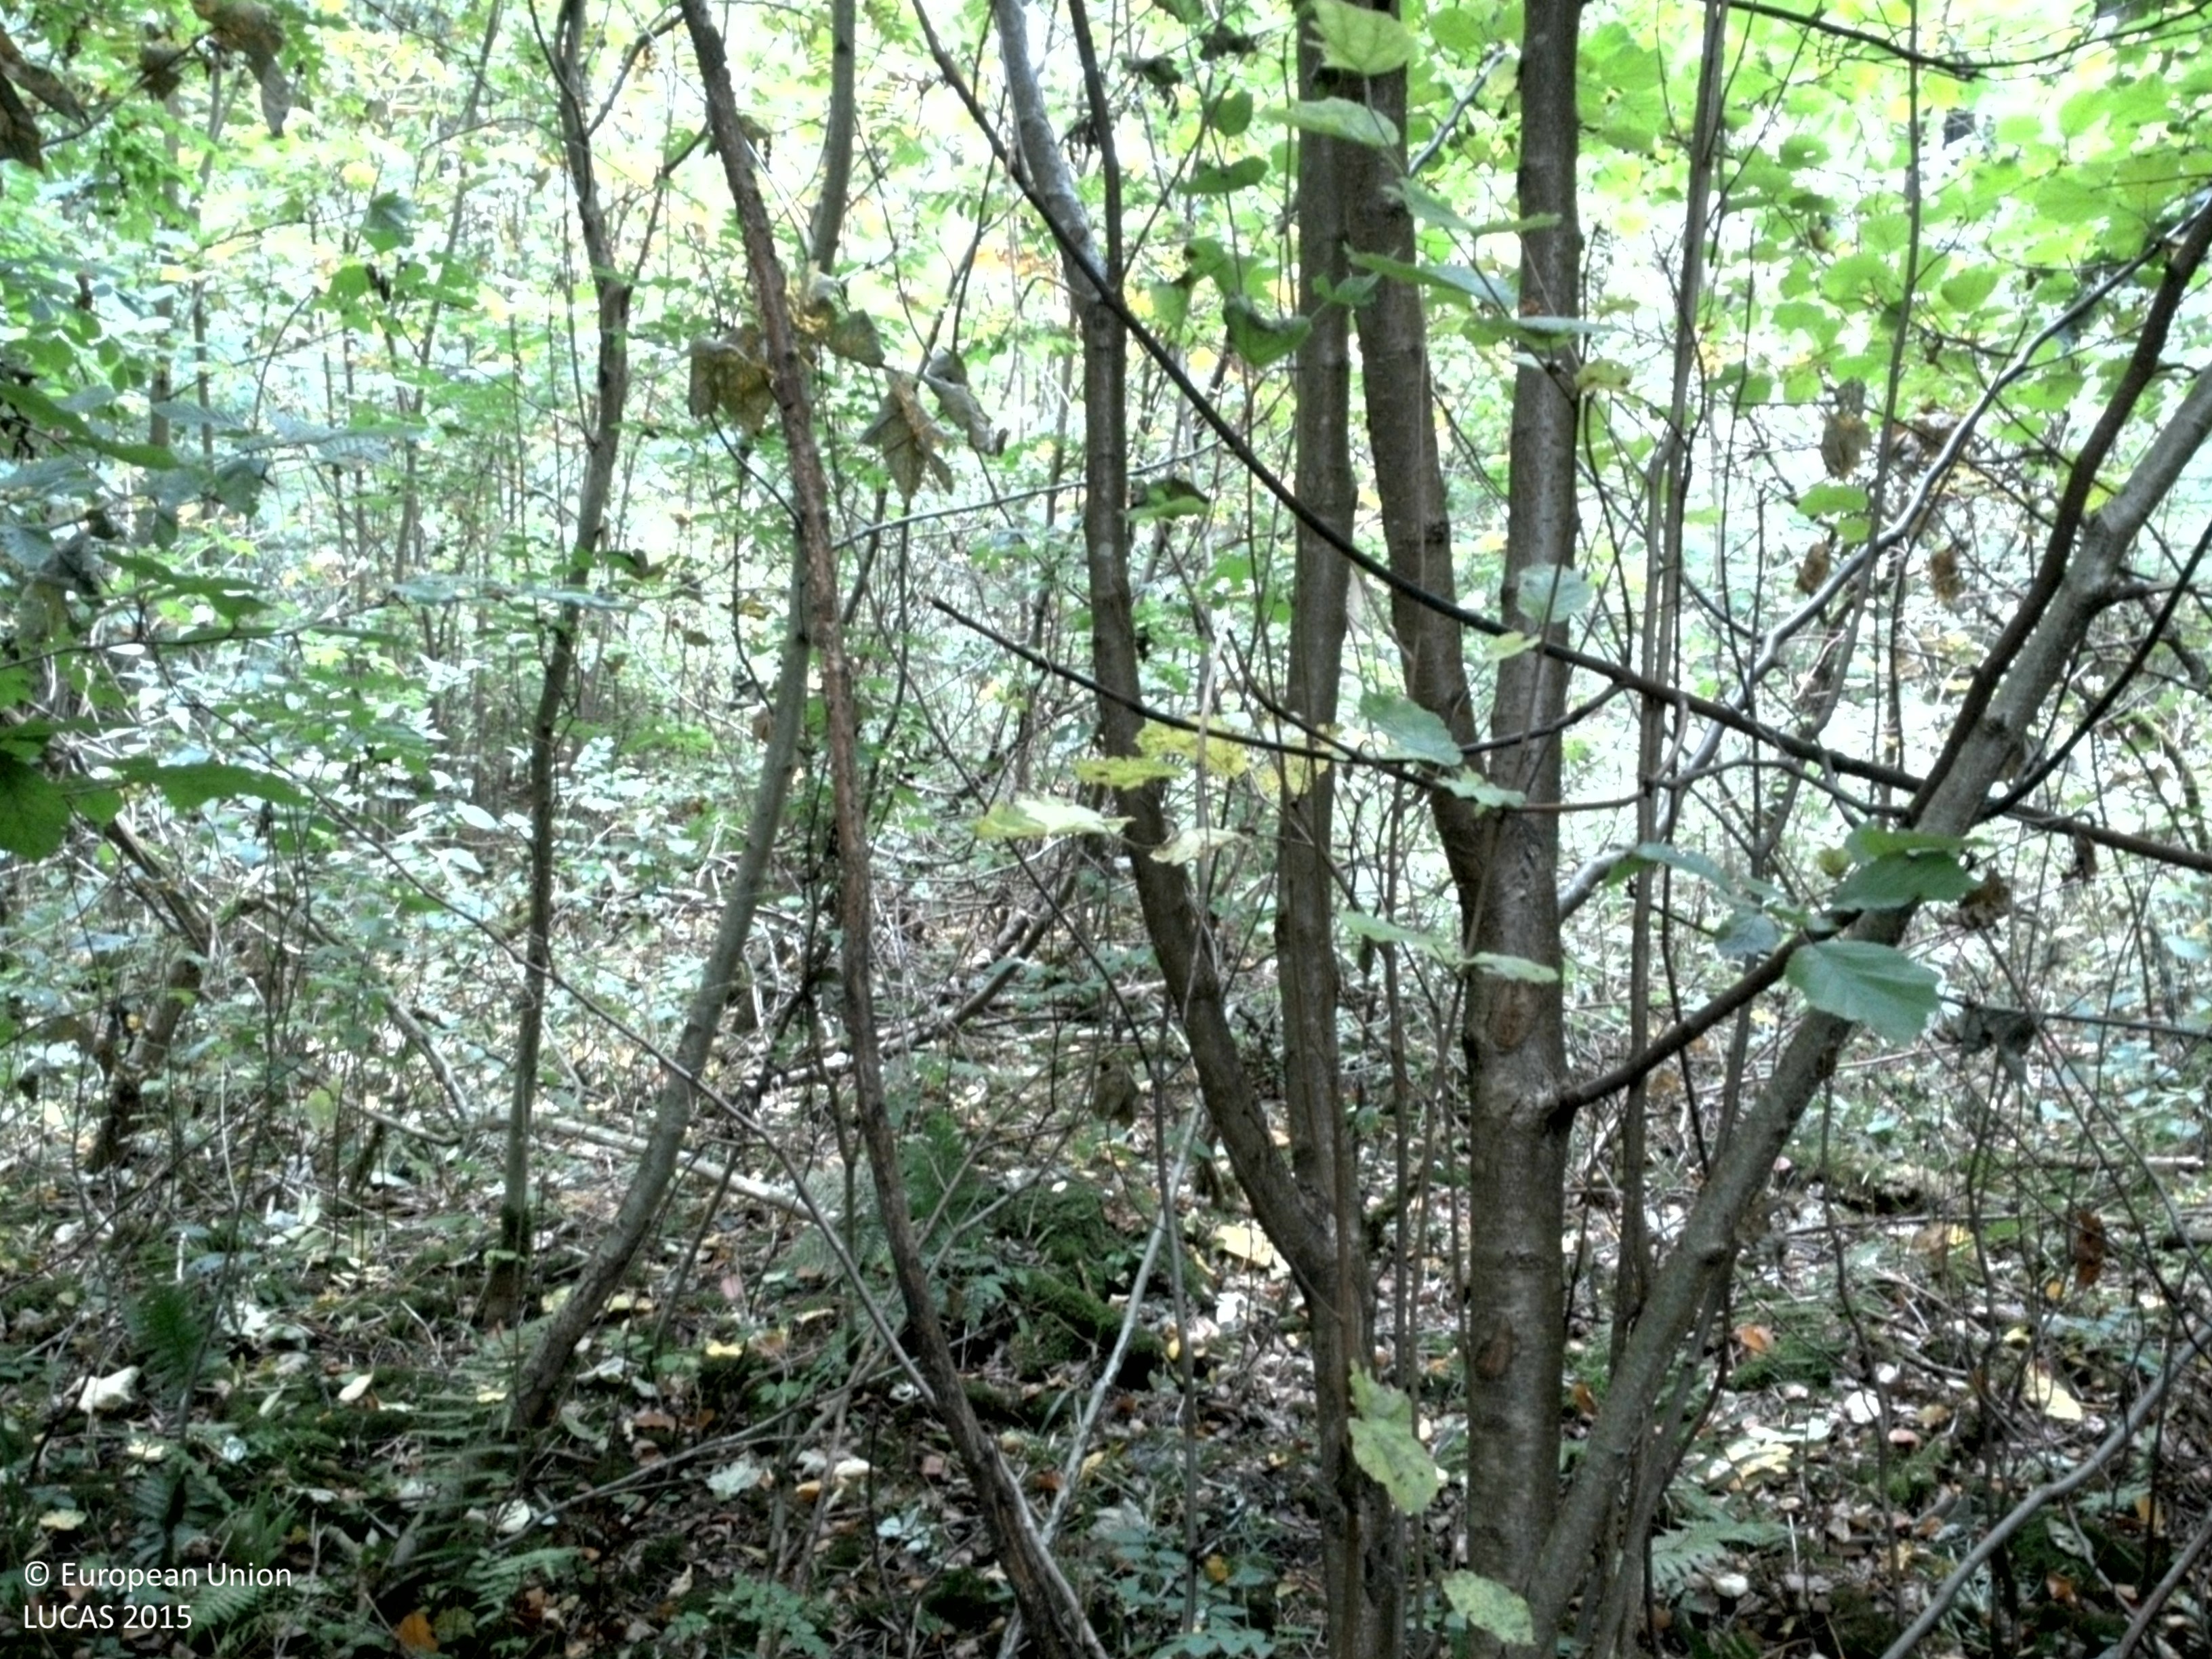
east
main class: Woodland
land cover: Broadleaved woodland
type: beech forest
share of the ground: > 75 %
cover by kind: broadleaved forest trees 80 %, unconsolidated bare surface 10 %, shrubs 5 %, herbaceous plants 5 %
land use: Forestry
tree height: > 5 m
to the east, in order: Broadleaved woodland; Grassland without tree/shrub cover; Broadleaved woodland; Grassland without tree/shrub cover; Broadleaved woodland
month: October
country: SE
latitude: 55.6379
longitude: 14.0494
